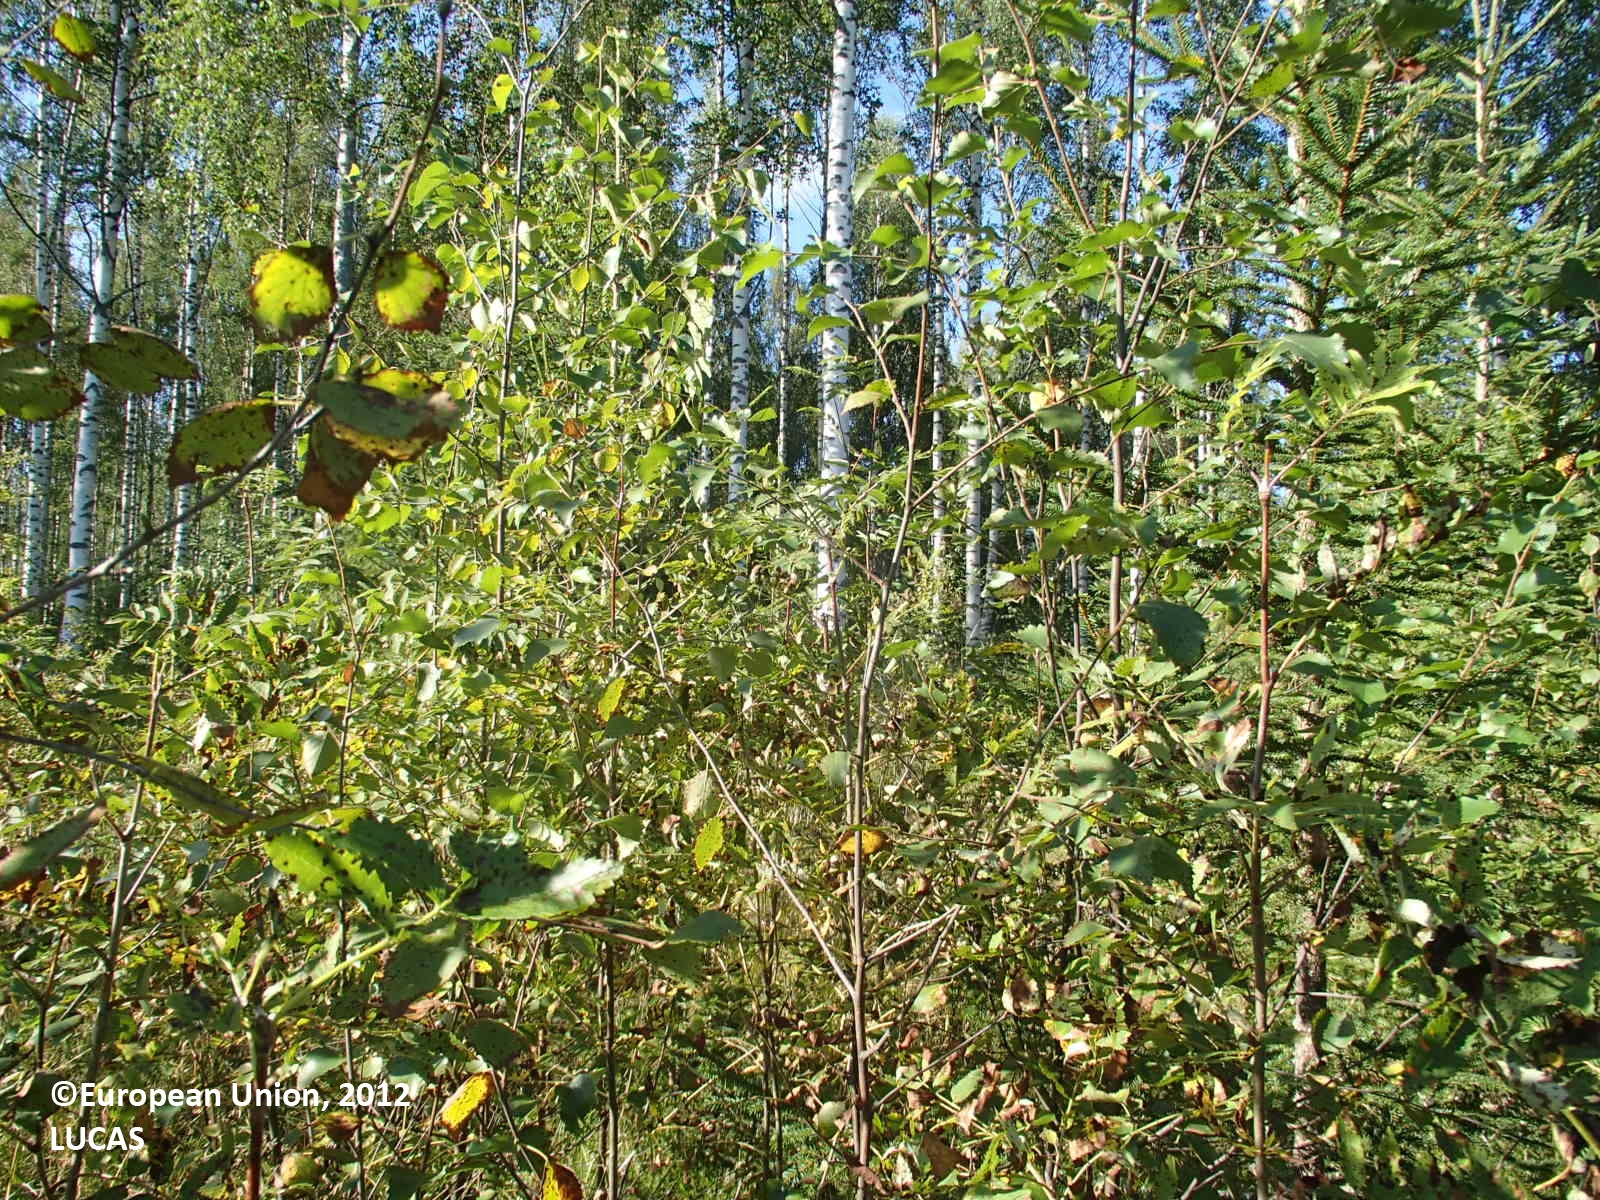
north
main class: Woodland
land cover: Spruce dominated mixed woodland
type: boreal forest
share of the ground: > 75 %
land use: Forestry
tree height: < 5 m
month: August
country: FI
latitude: 63.5529
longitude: 27.8982
